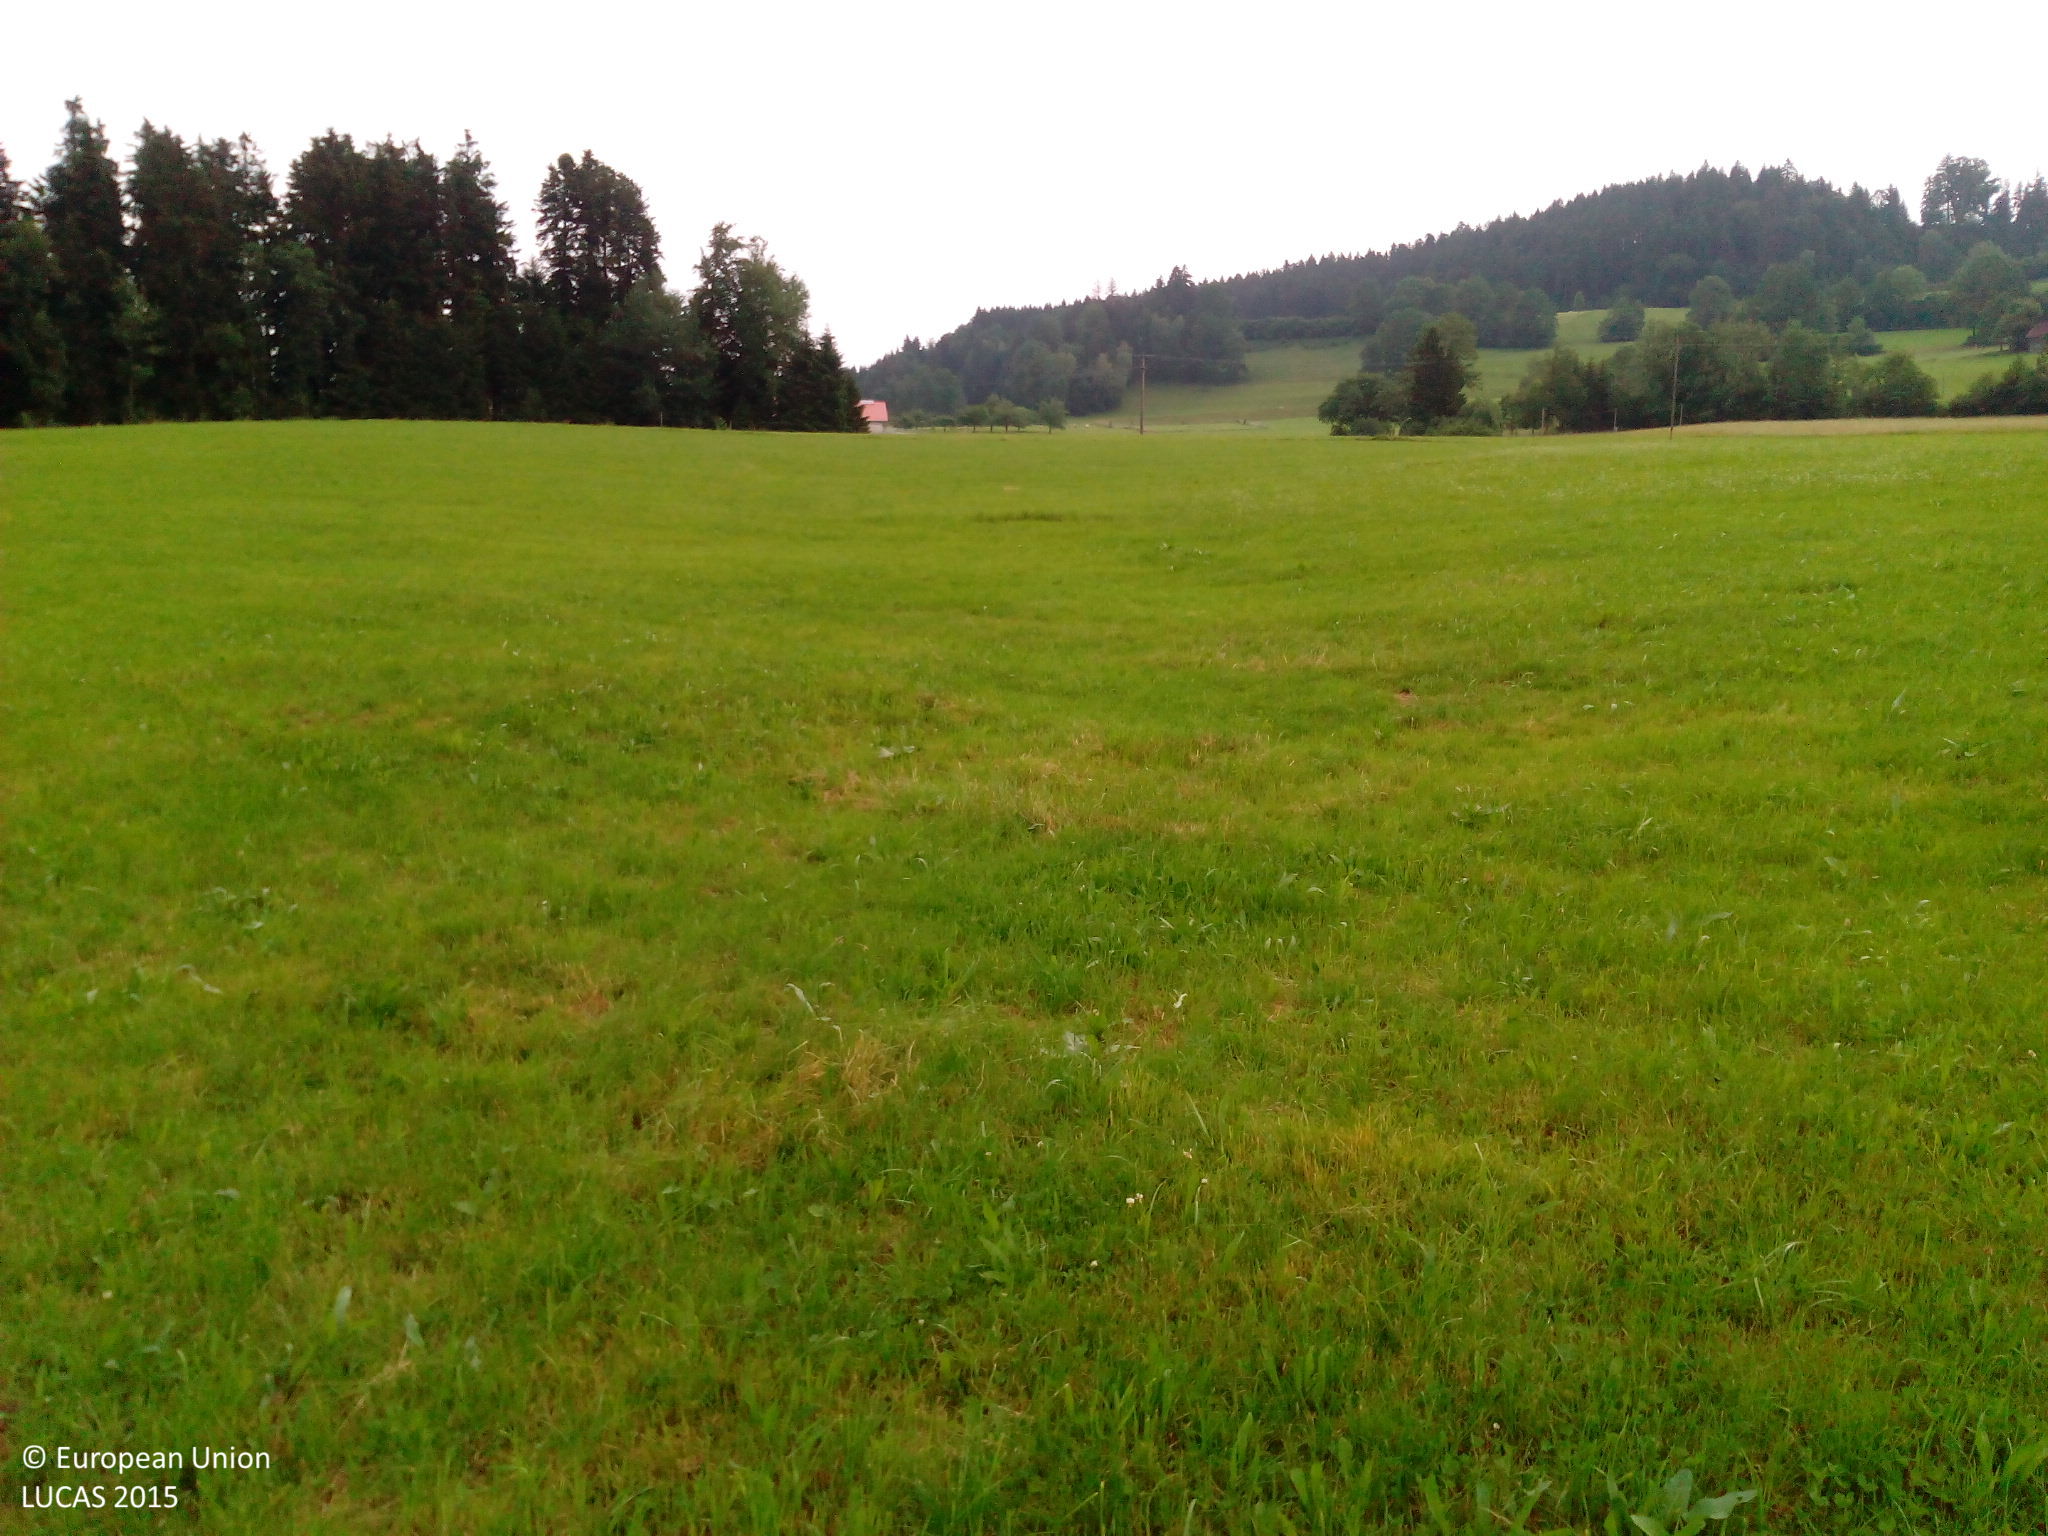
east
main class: Grassland
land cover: Grassland without tree/shrub cover
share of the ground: > 75 %
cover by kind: herbaceous plants 100 %
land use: Agriculture (excluding fallow land and kitchen gardens)
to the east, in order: Grassland without tree/shrub cover; Fences; Grassland without tree/shrub cover; Electric lines; Grassland without tree/shrub cover
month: June
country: DE
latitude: 47.5936
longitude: 9.9336
